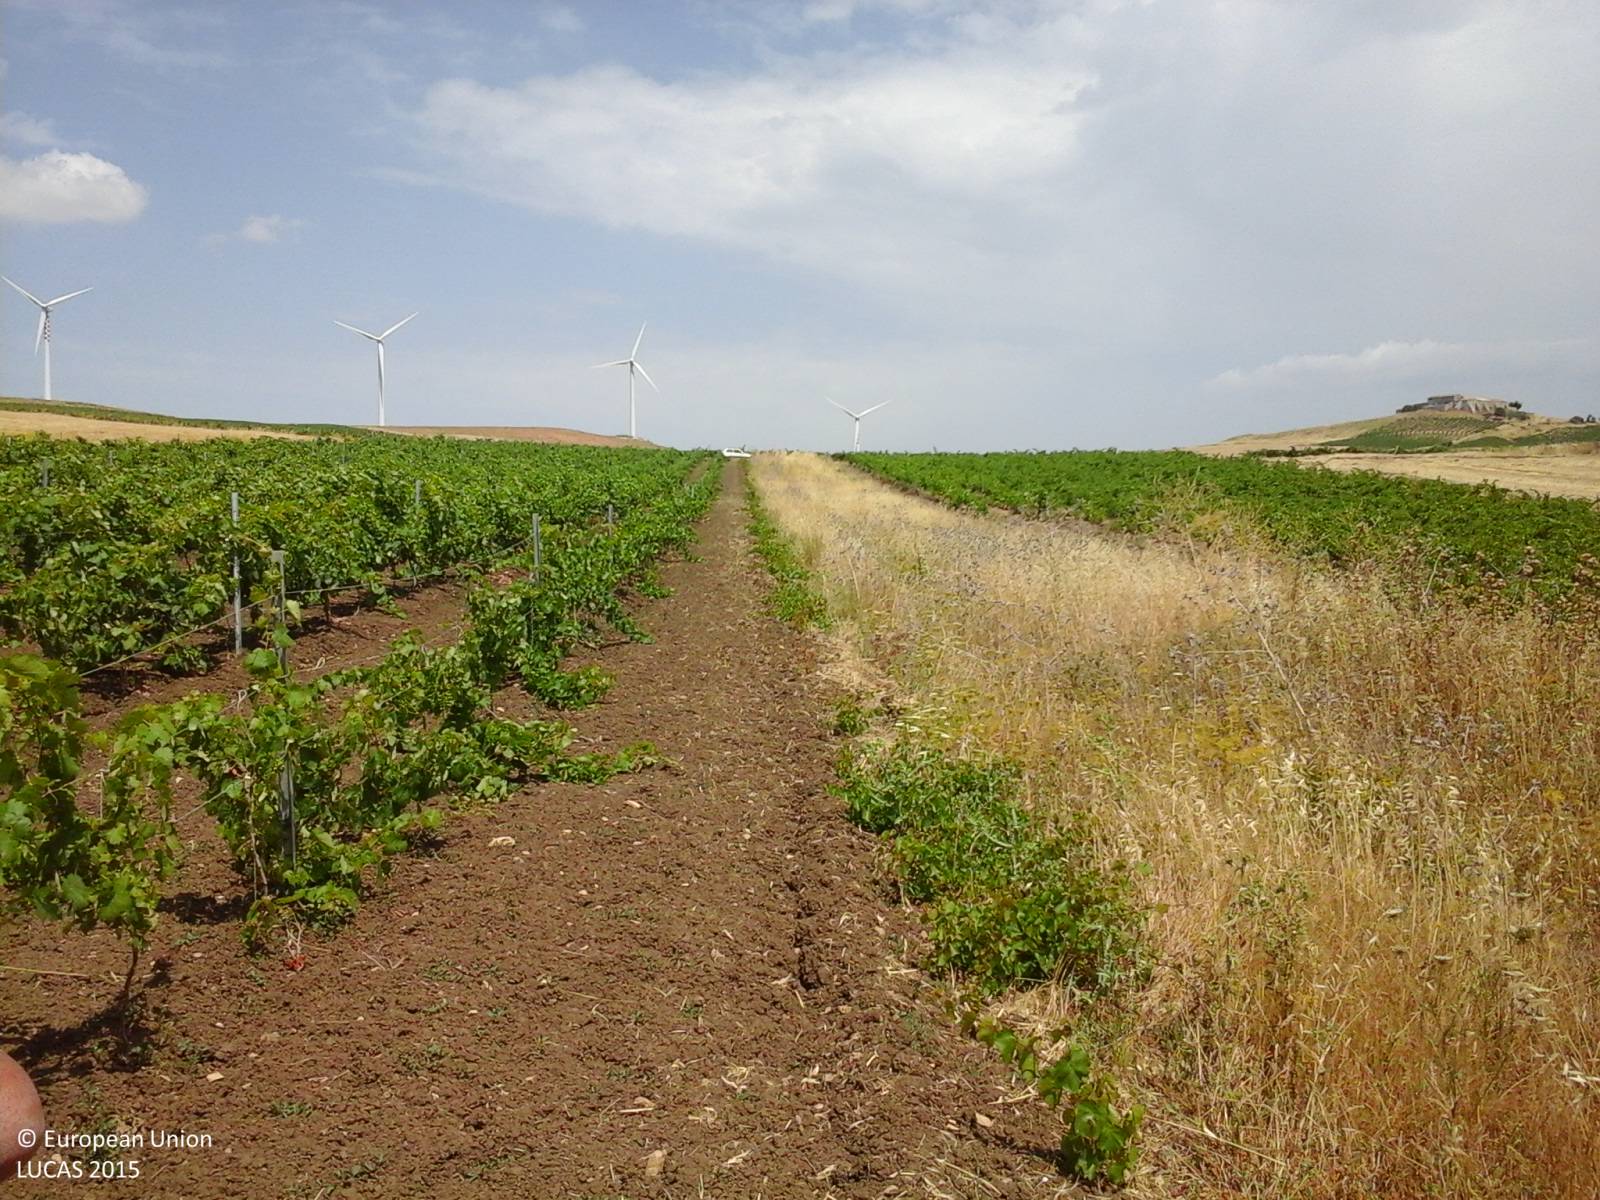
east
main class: Cropland
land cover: Vineyards
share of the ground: 50 - 75 %
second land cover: Other bare soil
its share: > 75 %
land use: Agriculture (excluding fallow land and kitchen gardens)
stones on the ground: < 10 %
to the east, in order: Vineyards; Other bare soil
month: June
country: IT
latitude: 37.8546
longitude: 12.6964
